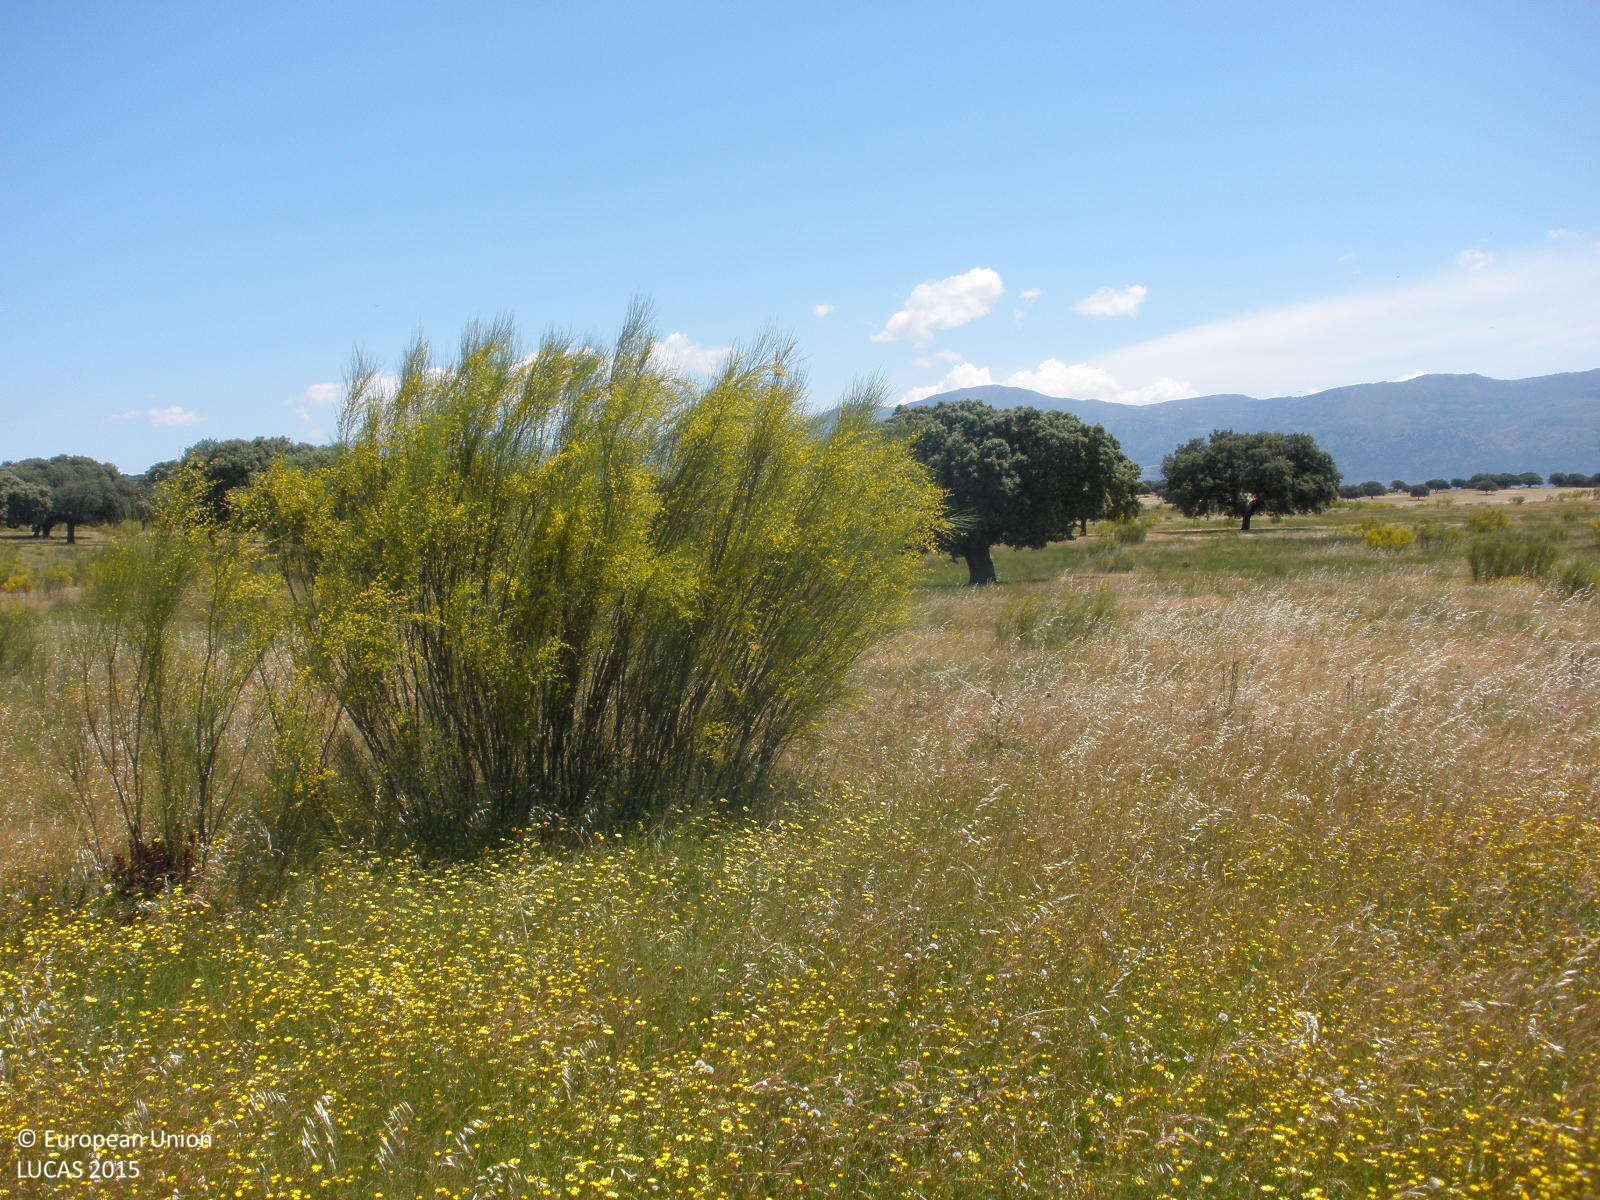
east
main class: Shrubland
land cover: Shrubland without tree cover
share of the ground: > 75 %
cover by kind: herbaceous plants 80 %, shrubs 20 %
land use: Agriculture (excluding fallow land and kitchen gardens)
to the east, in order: Shrubland without tree cover; Grassland with sparse tree/shrub cover; Shrubland with sparse tree cover; Grassland with sparse tree/shrub cover
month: May
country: ES
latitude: 40.1961
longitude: -6.1091
